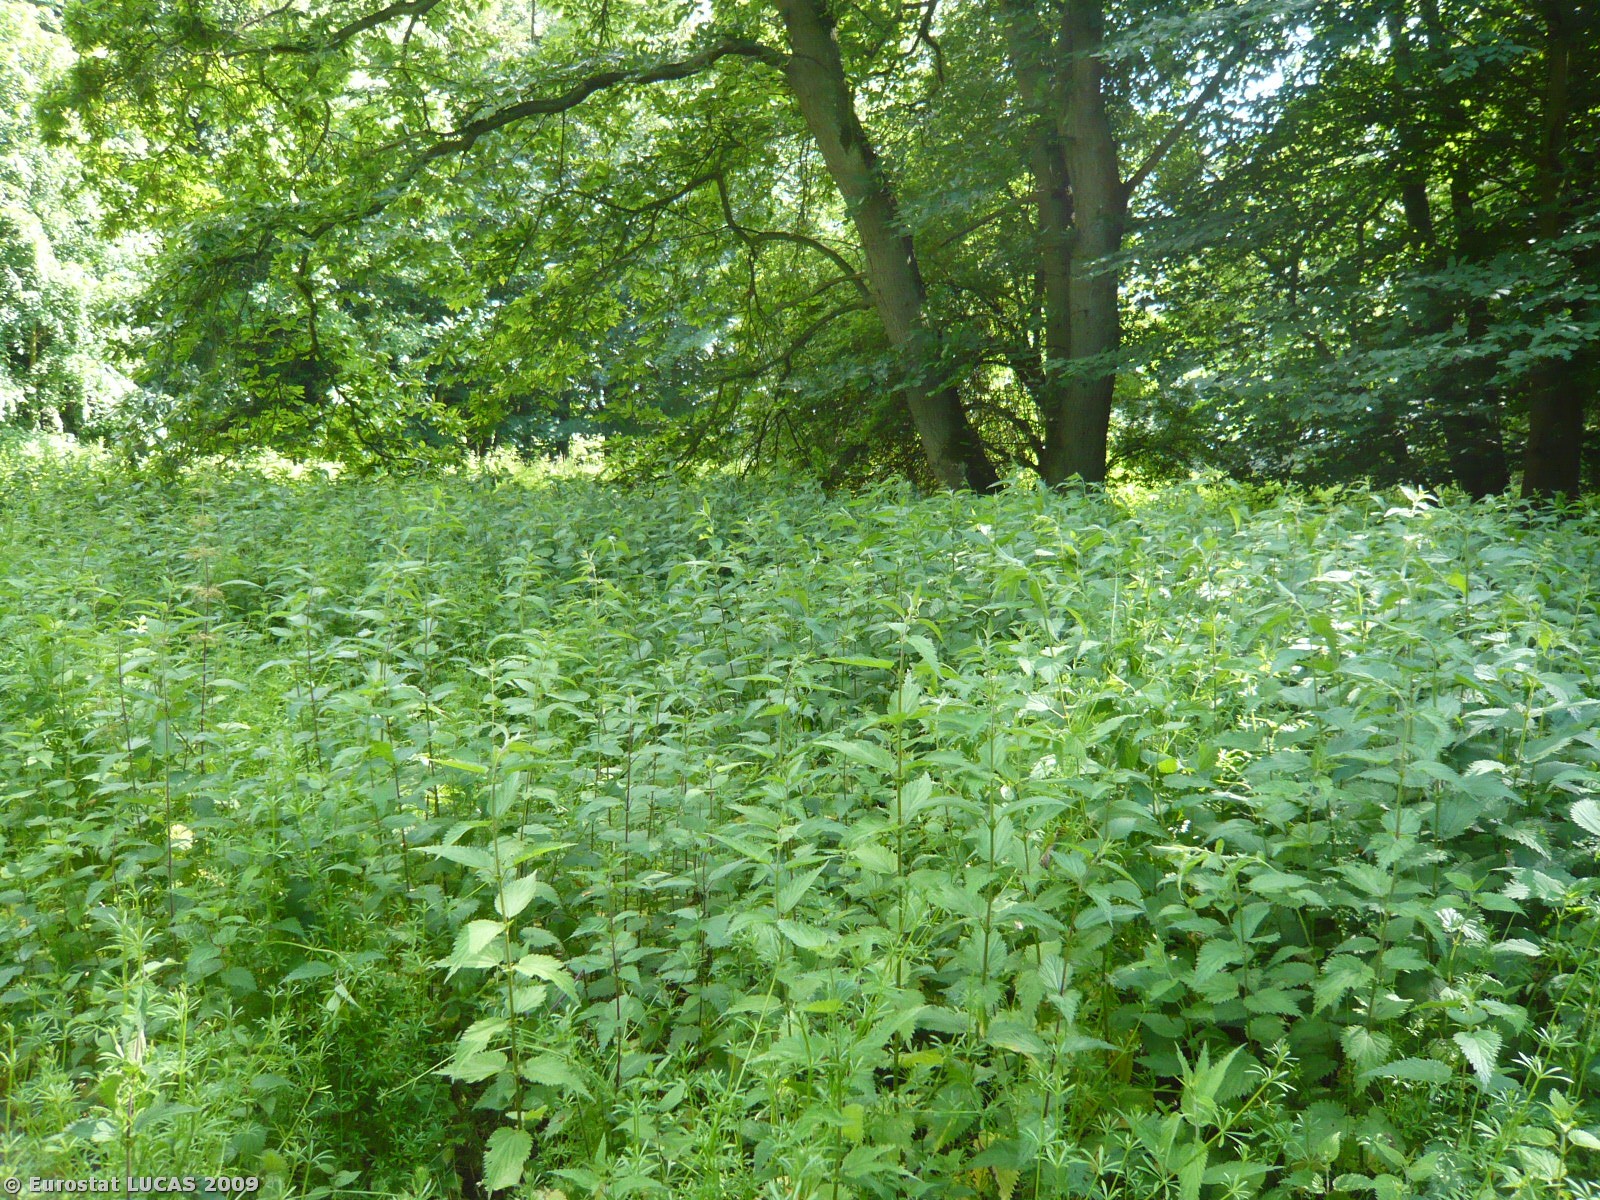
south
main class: Woodland
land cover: Broadleaved woodland
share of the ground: 50 - 75 %
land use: Residential
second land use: Amenities, museums, leisure
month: June
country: DK
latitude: 54.7404
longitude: 11.5367
